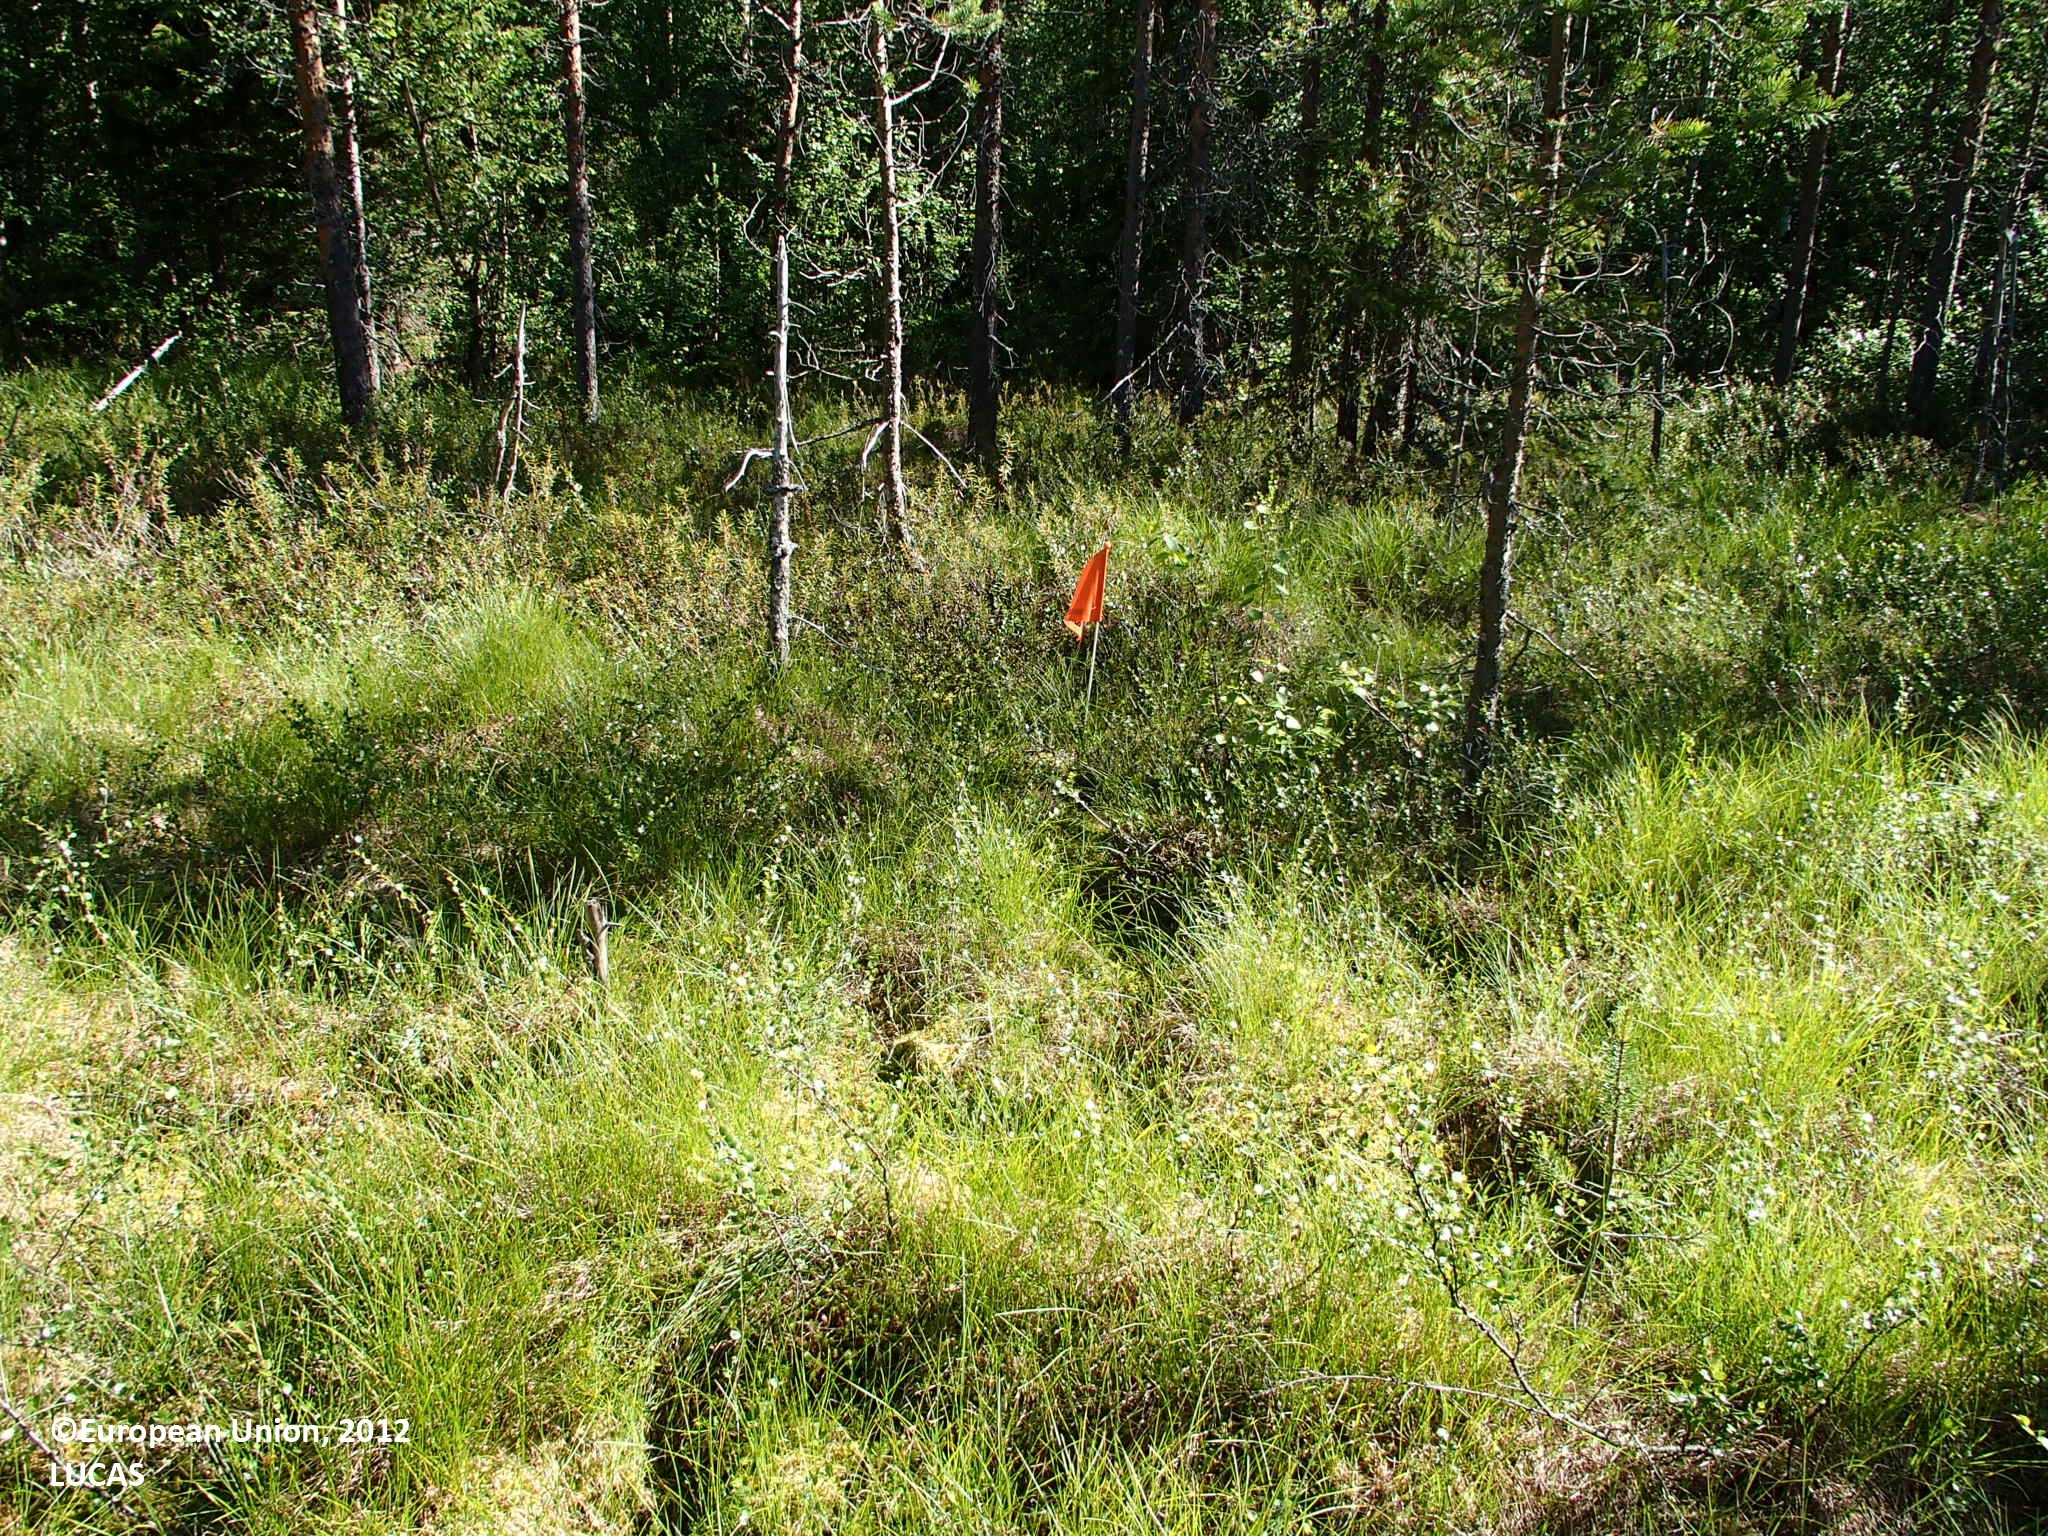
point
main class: Woodland
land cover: Pine dominated coniferous woodland
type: boreal forest
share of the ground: 25 - 50 %
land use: Forestry
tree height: > 5 m
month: July
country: FI
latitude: 66.8292
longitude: 25.3378
